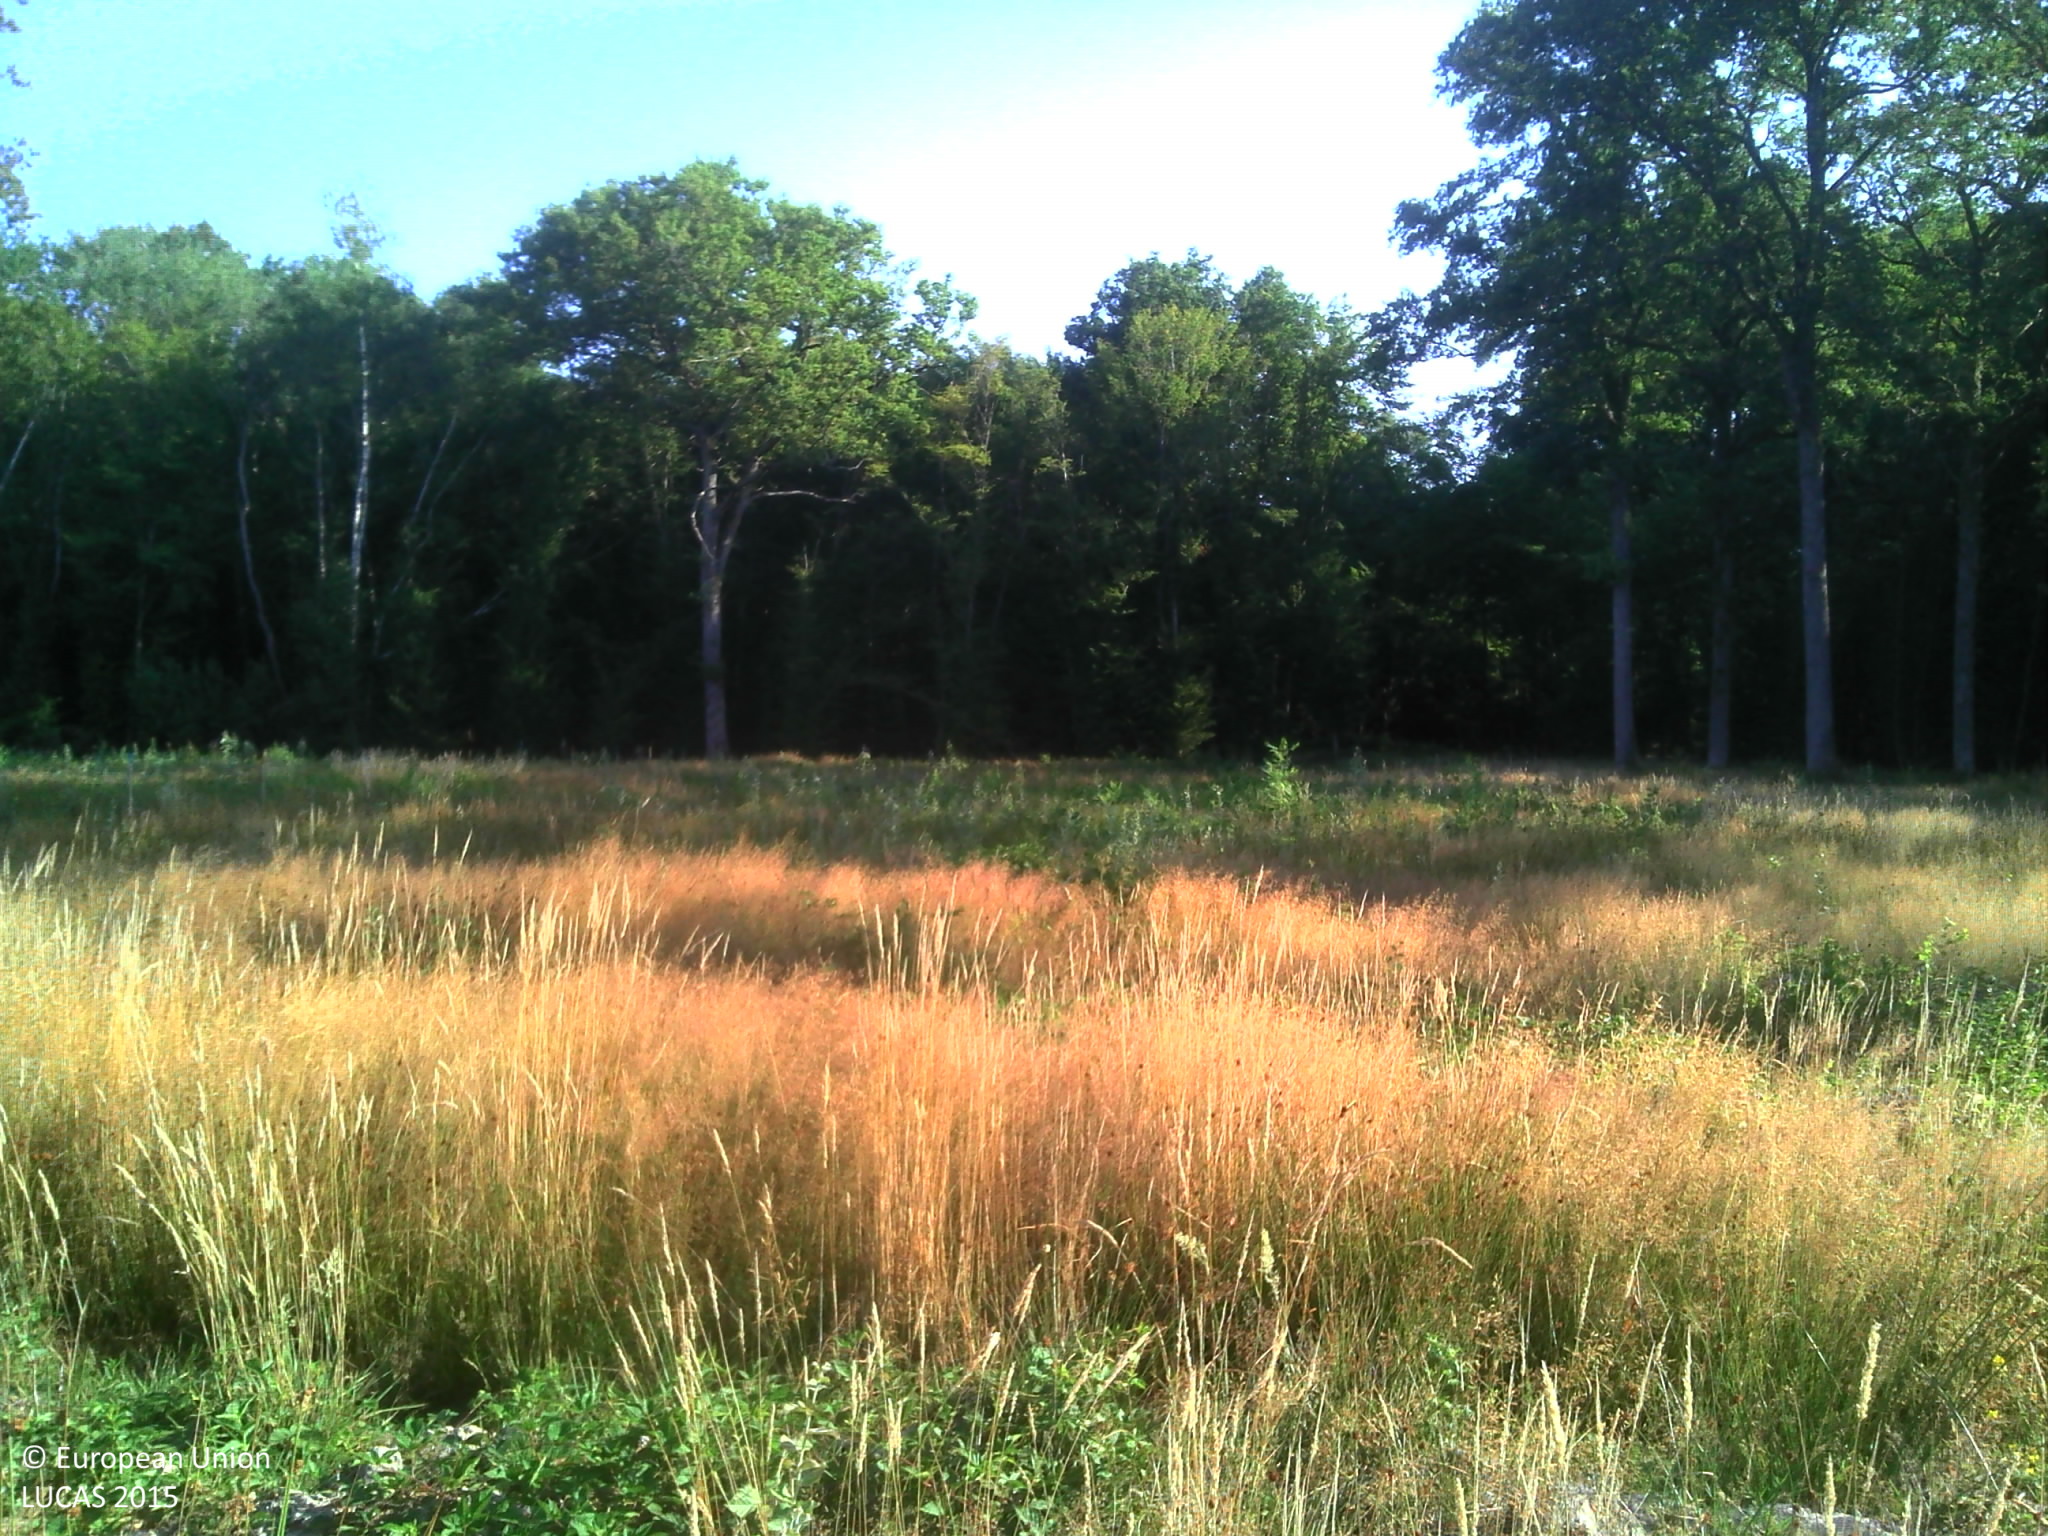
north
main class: Woodland
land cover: Broadleaved woodland
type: mesophytic deciduous forest
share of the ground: > 75 %
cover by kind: broadleaved forest trees 90 %, shrubs 10 %
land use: Forestry
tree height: > 5 m
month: July
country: FR
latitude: 46.7989
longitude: 5.1145
